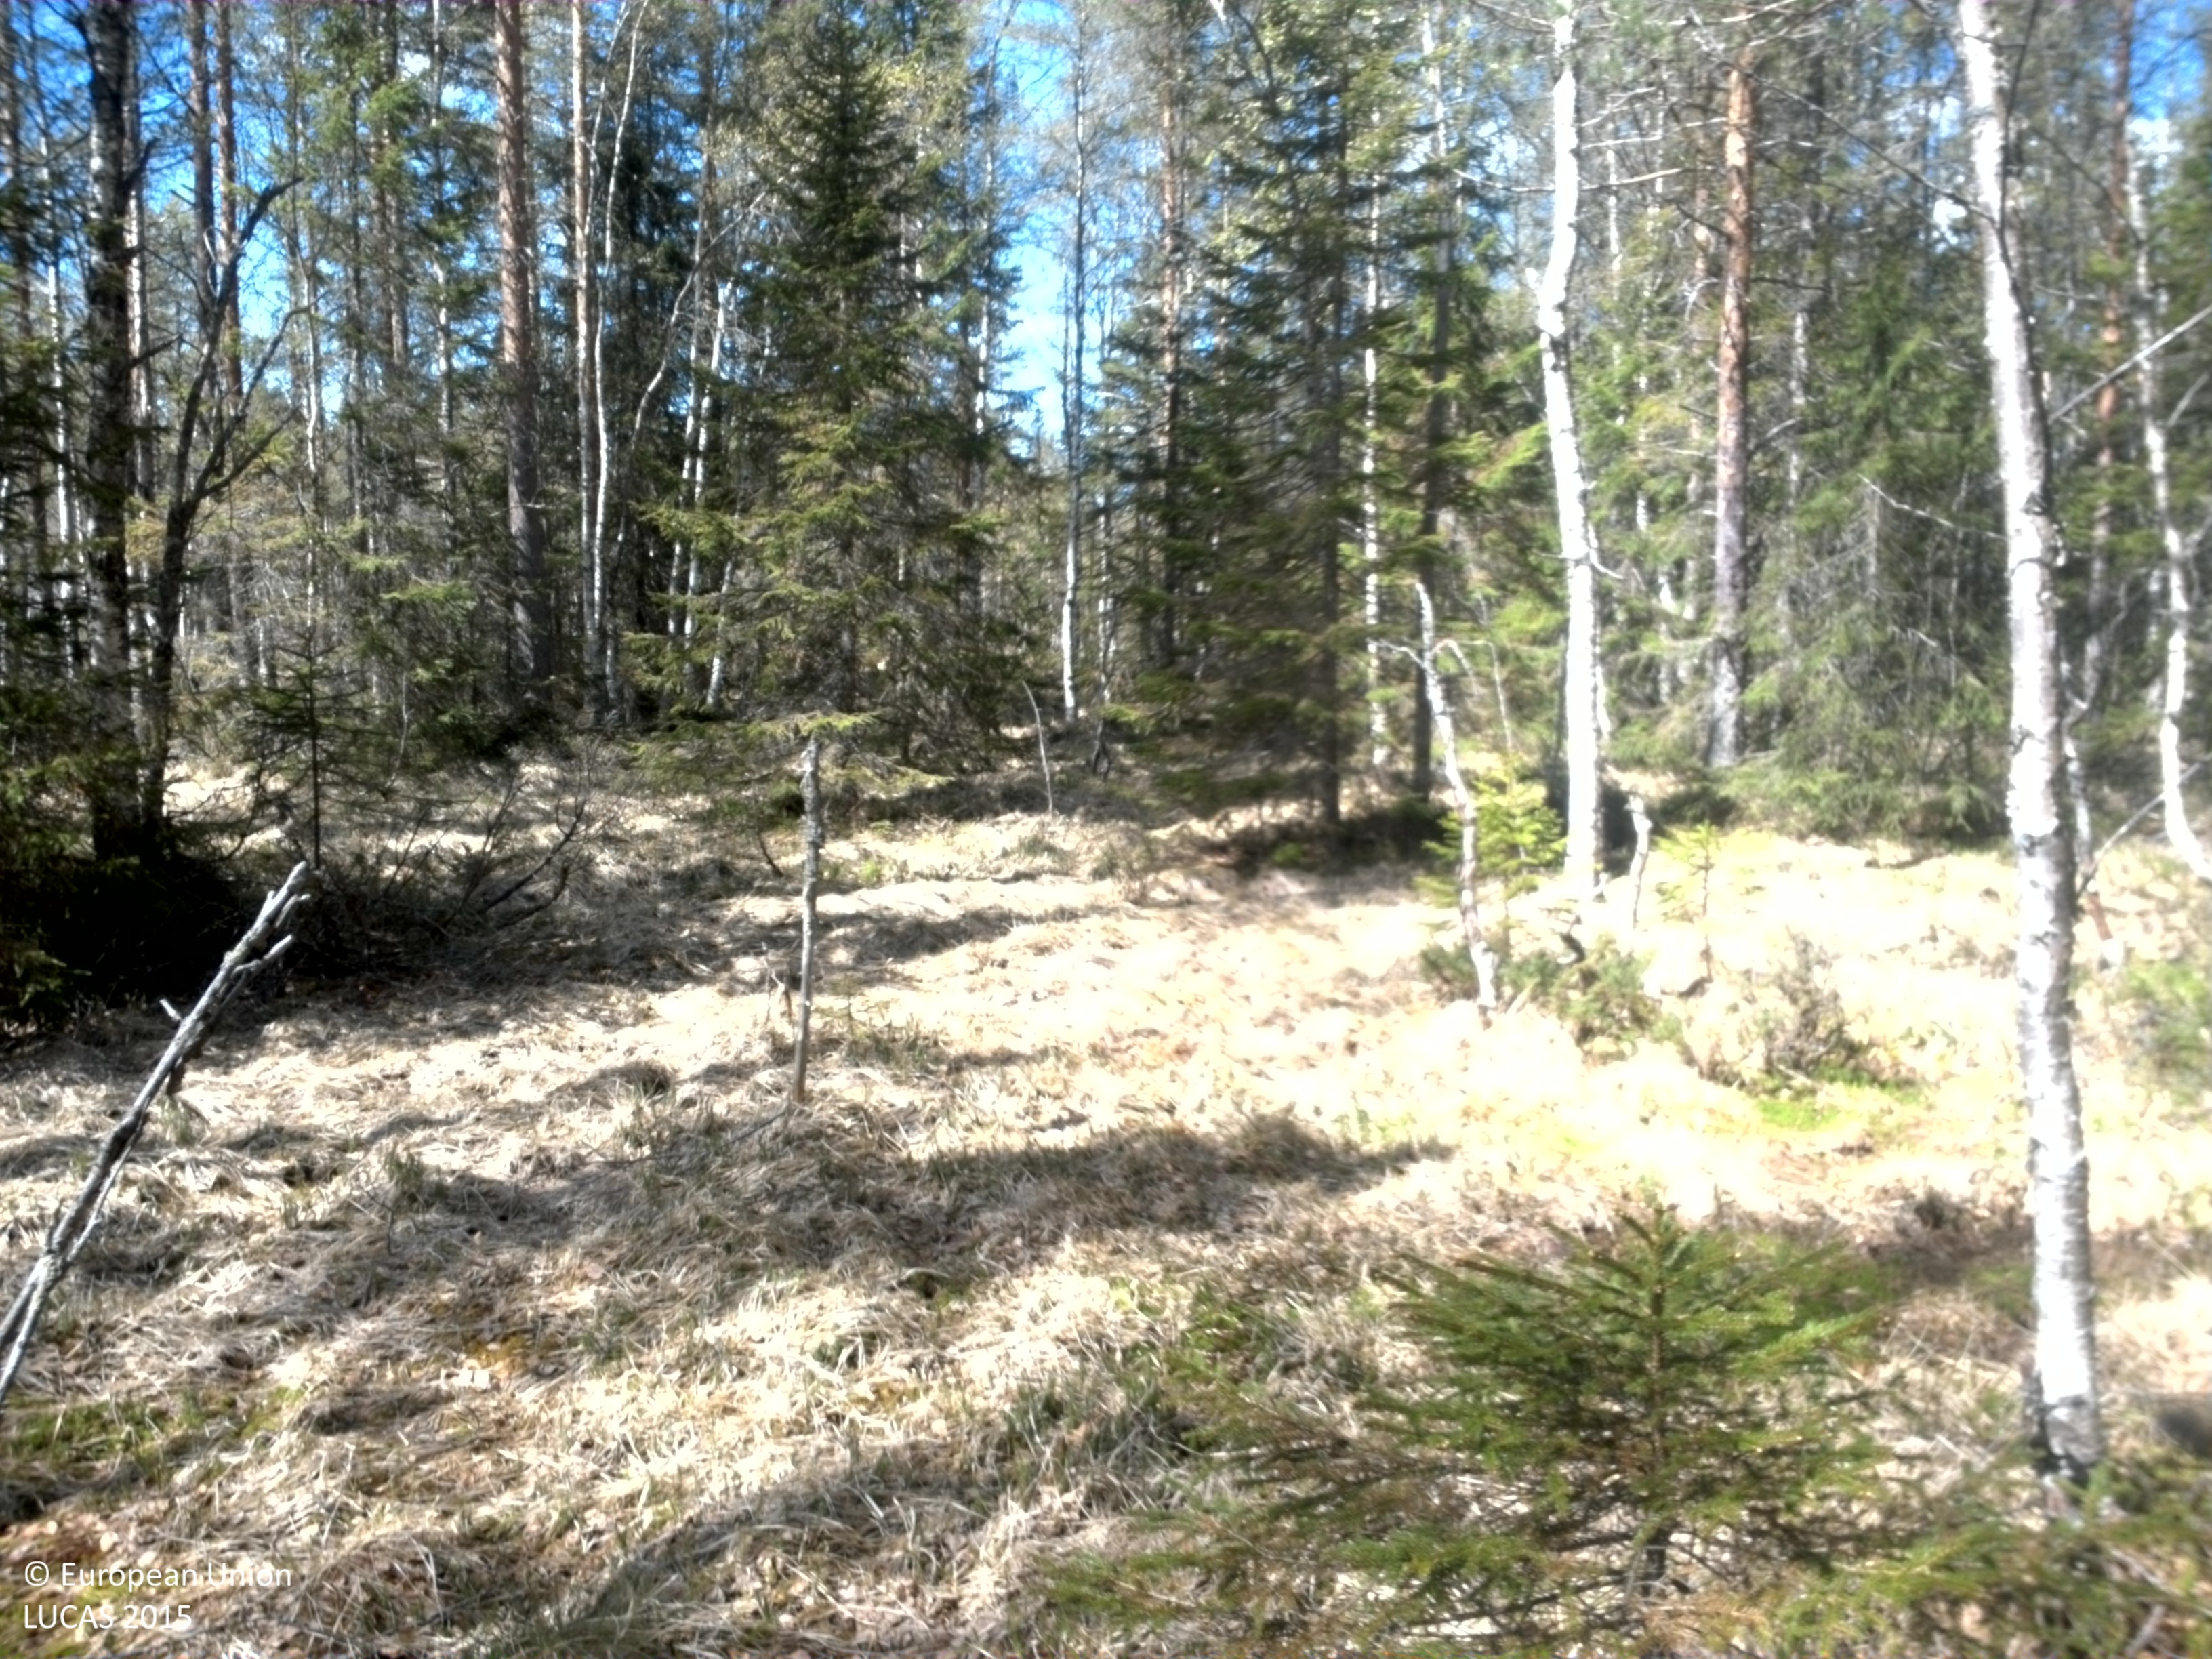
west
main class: Woodland
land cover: Pine dominated mixed woodland
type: boreal forest
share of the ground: 50 - 75 %
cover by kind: coniferous forest trees 50 %, broadleaved forest trees 25 %, herbaceous plants 15 %, shrubs 10 %
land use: Forestry
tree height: > 5 m
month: June
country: SE
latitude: 61.2041
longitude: 13.3569
